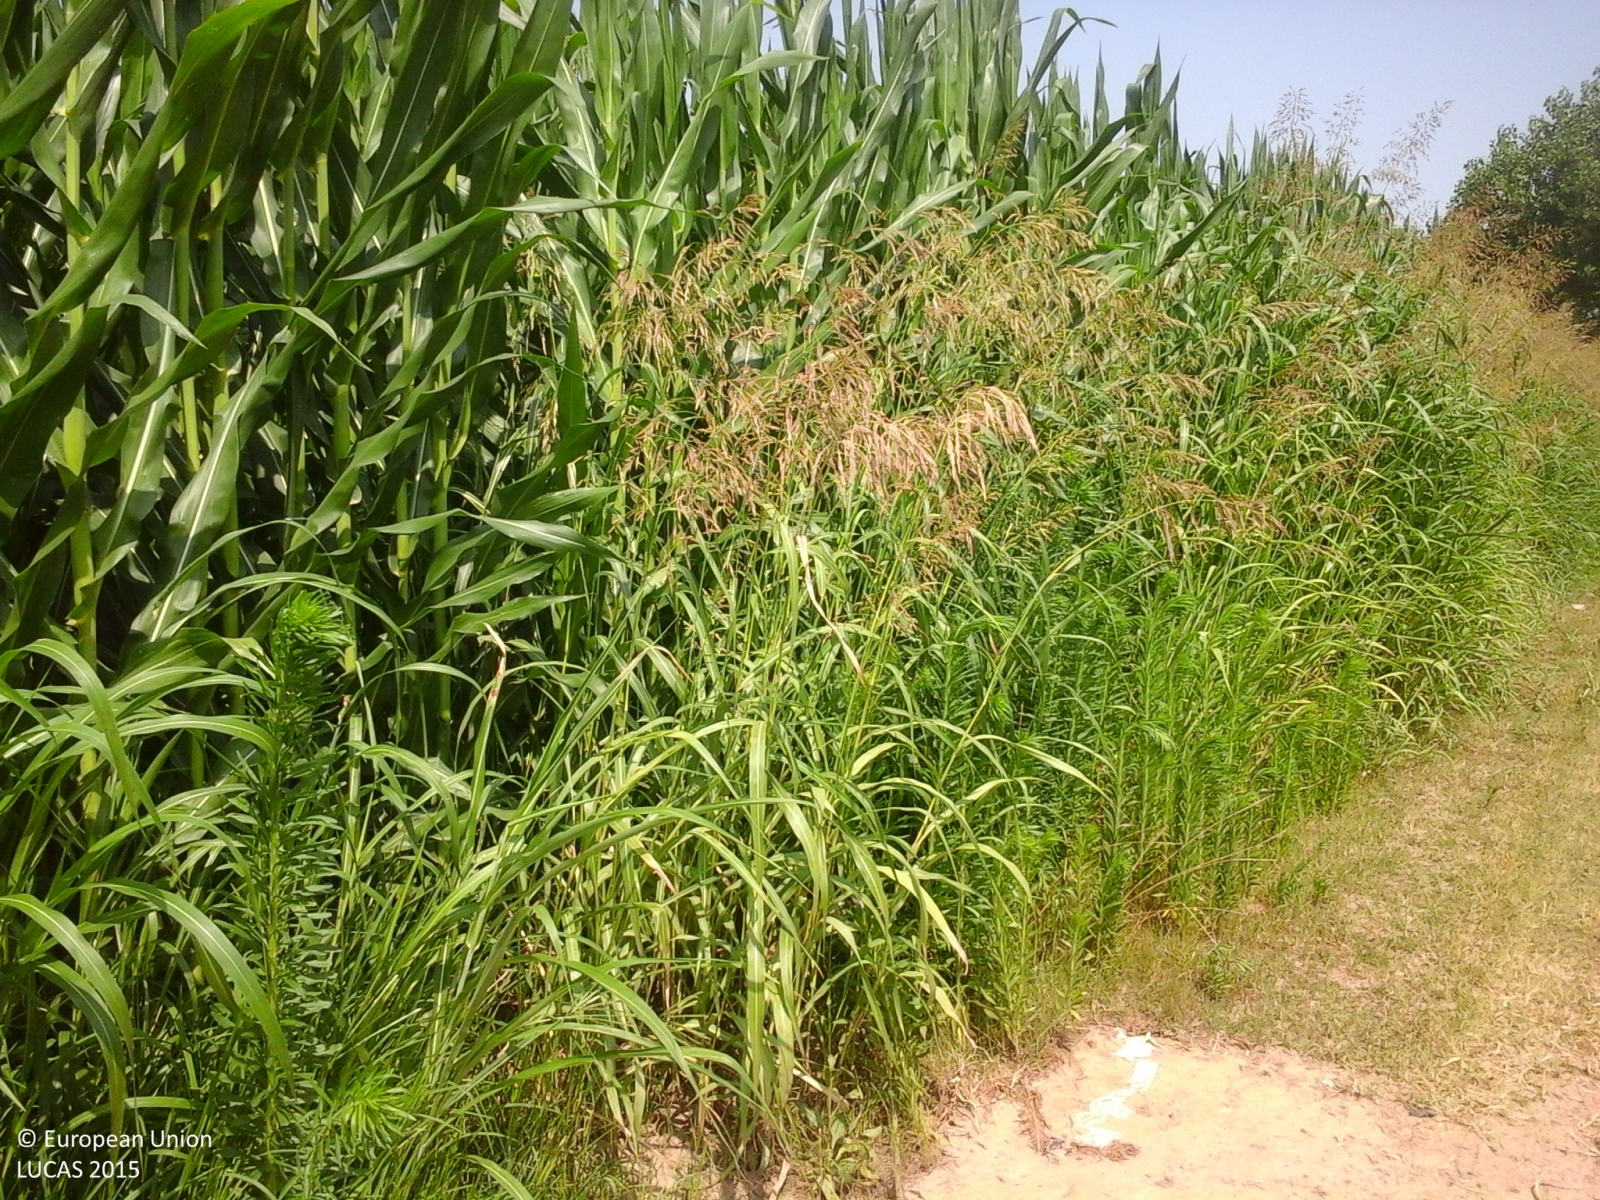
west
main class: Cropland
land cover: Maize
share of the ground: > 75 %
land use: Agriculture (excluding fallow land and kitchen gardens)
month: July
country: IT
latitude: 45.2836
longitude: 10.9799
